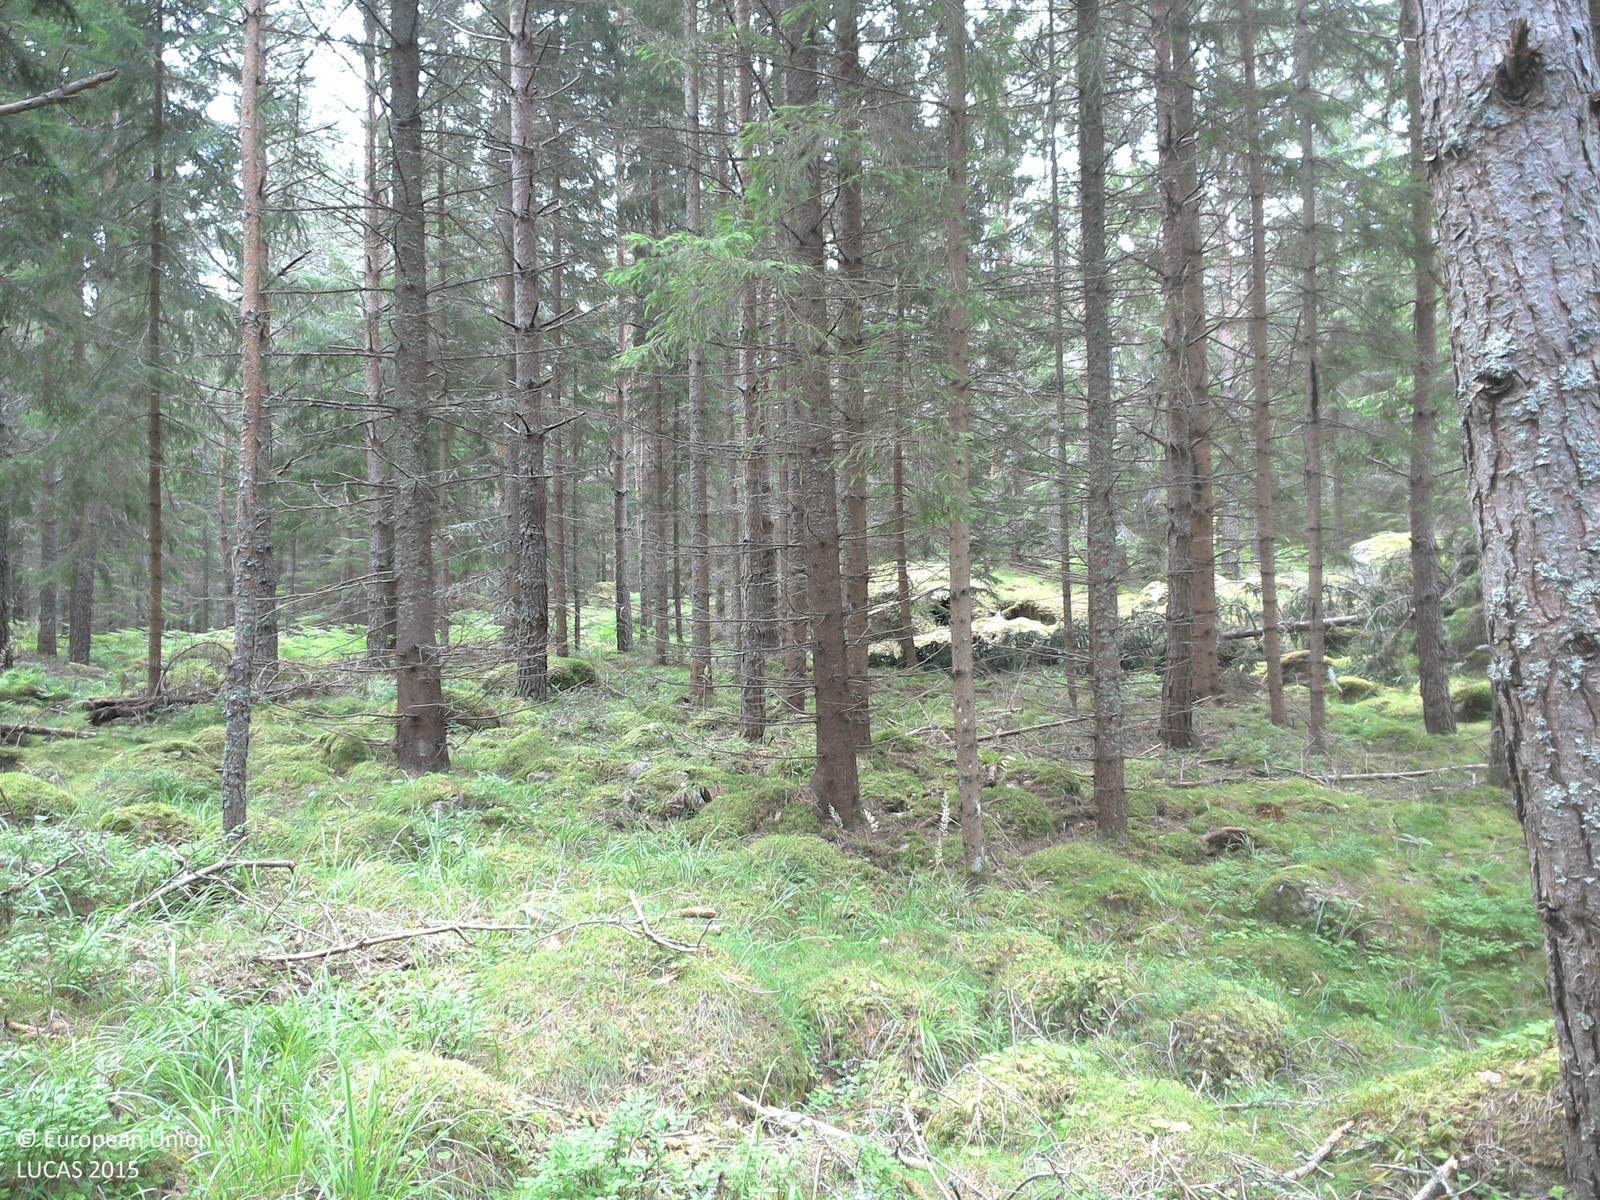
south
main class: Woodland
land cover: Pine dominated coniferous woodland
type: boreal forest
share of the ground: 50 - 75 %
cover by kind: coniferous forest trees 60 %, herbaceous plants 30 %, lichens and mosses 10 %
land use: Forestry
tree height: > 5 m
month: July
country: SE
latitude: 57.8684
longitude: 16.0149
